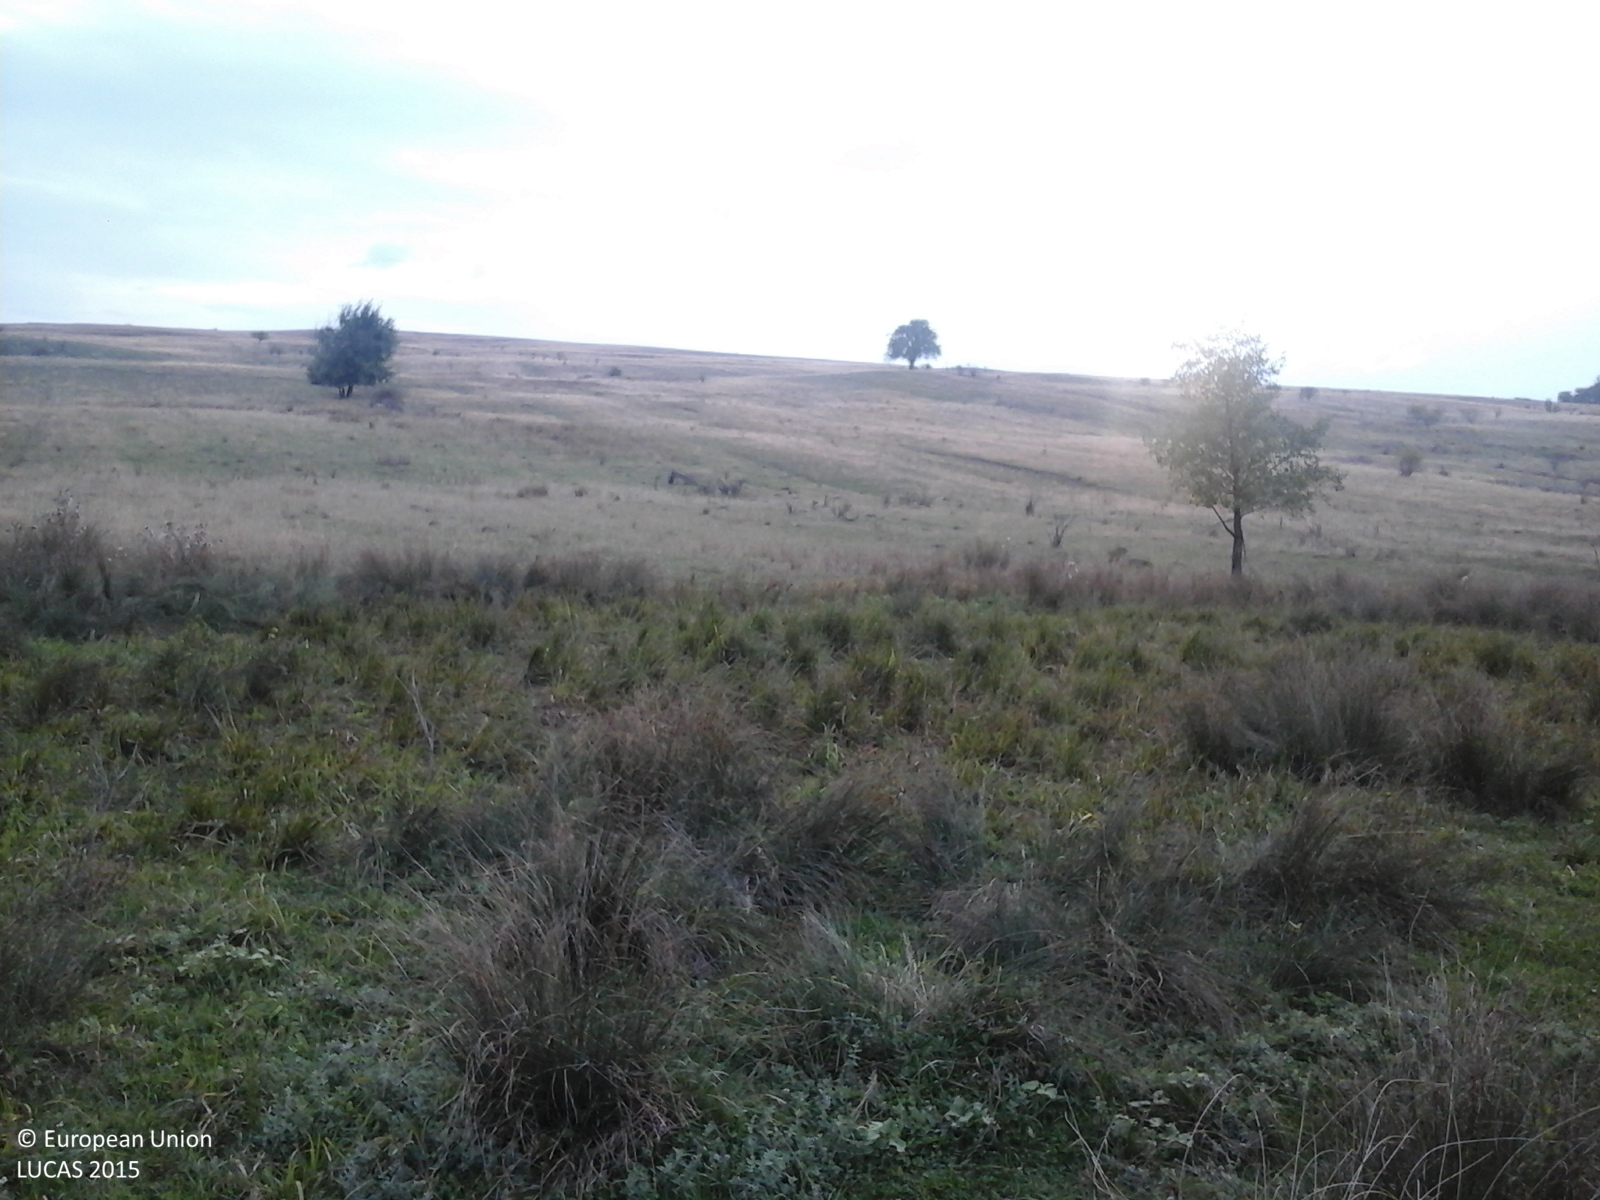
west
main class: Grassland
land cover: Grassland without tree/shrub cover
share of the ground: > 75 %
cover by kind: herbaceous plants 100 %
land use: Agriculture (excluding fallow land and kitchen gardens)
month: September
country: RO
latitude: 47.1402
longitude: 22.9981
